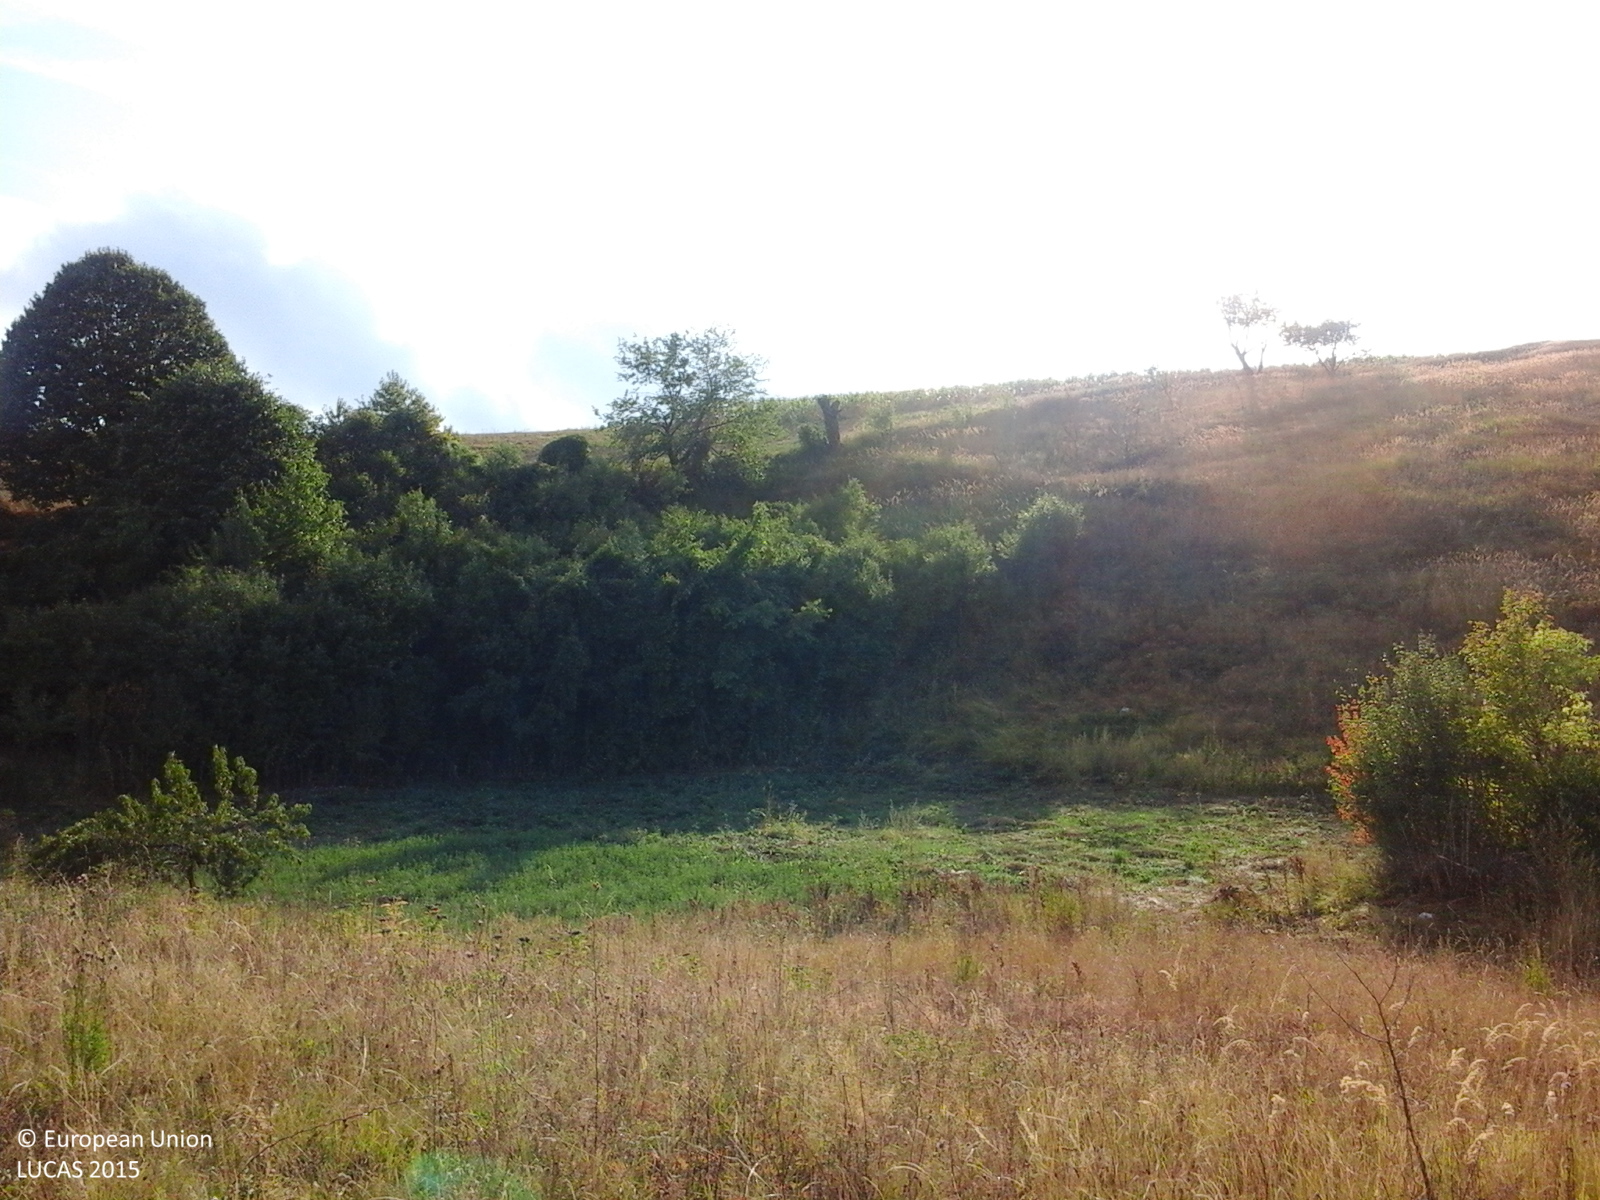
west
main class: Grassland
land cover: Spontaneously vegetated surfaces
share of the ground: > 75 %
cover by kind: herbaceous plants 100 %
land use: Fallow land
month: August
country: RO
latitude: 44.7473
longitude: 21.8155
